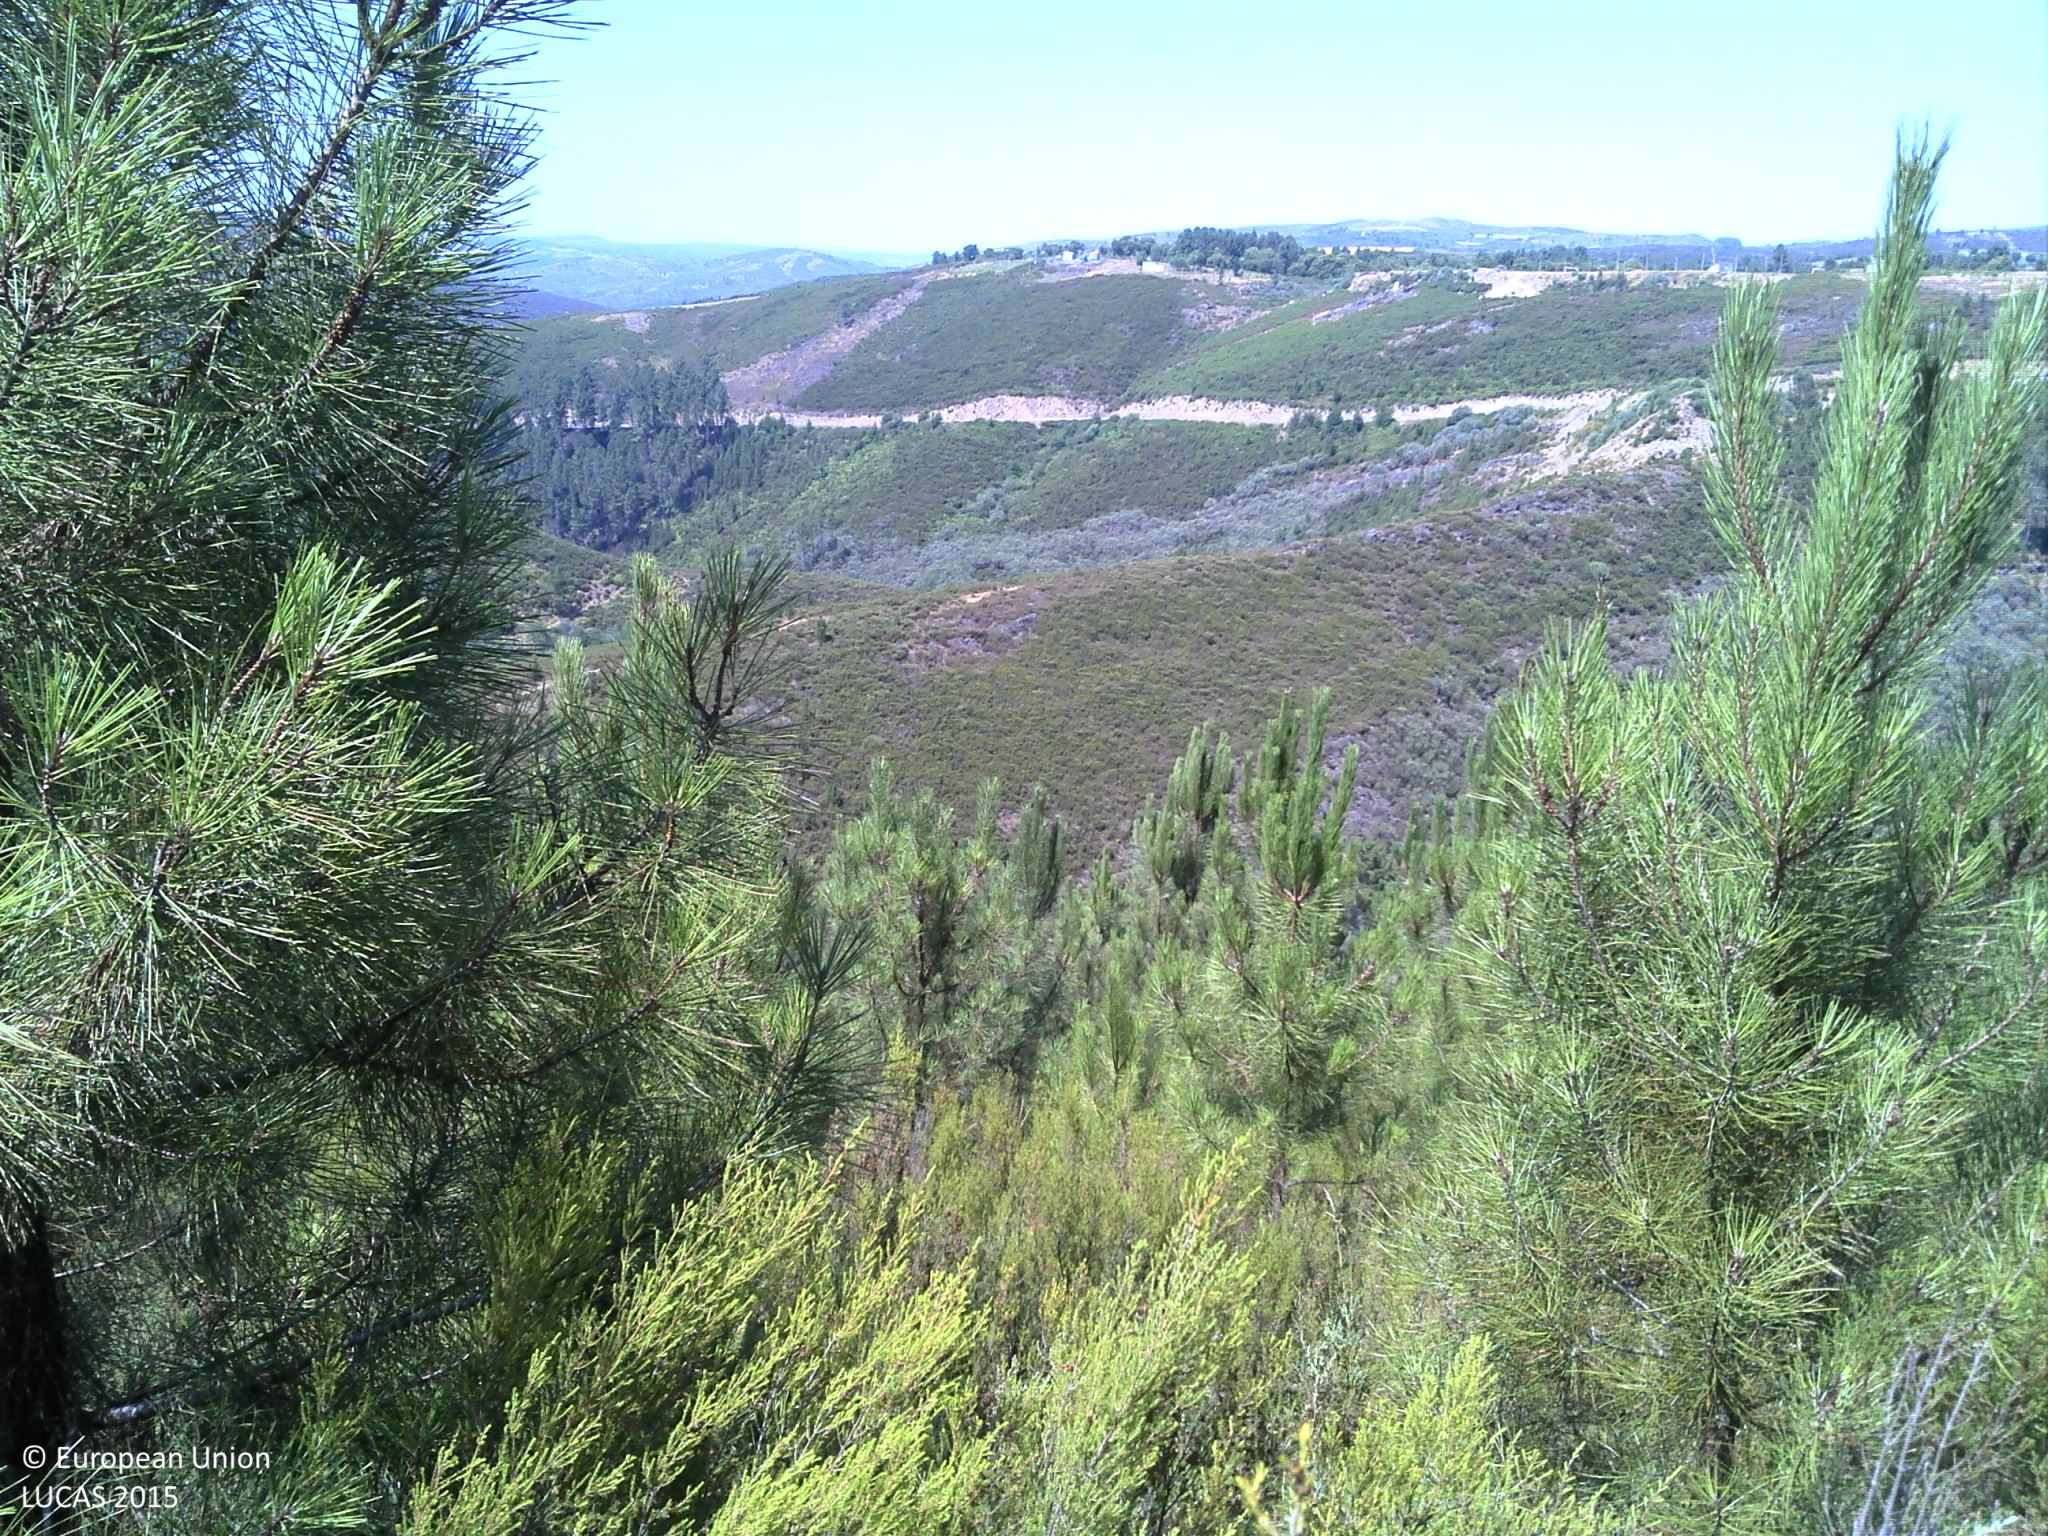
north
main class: Woodland
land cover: Pine dominated coniferous woodland
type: coniferous forest of the mediterranean region
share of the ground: 10 - 25 %
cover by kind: shrubs 85 %, coniferous forest trees 15 %
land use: Forestry
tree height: < 5 m
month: July
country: PT
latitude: 40.8485
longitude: -7.8589
